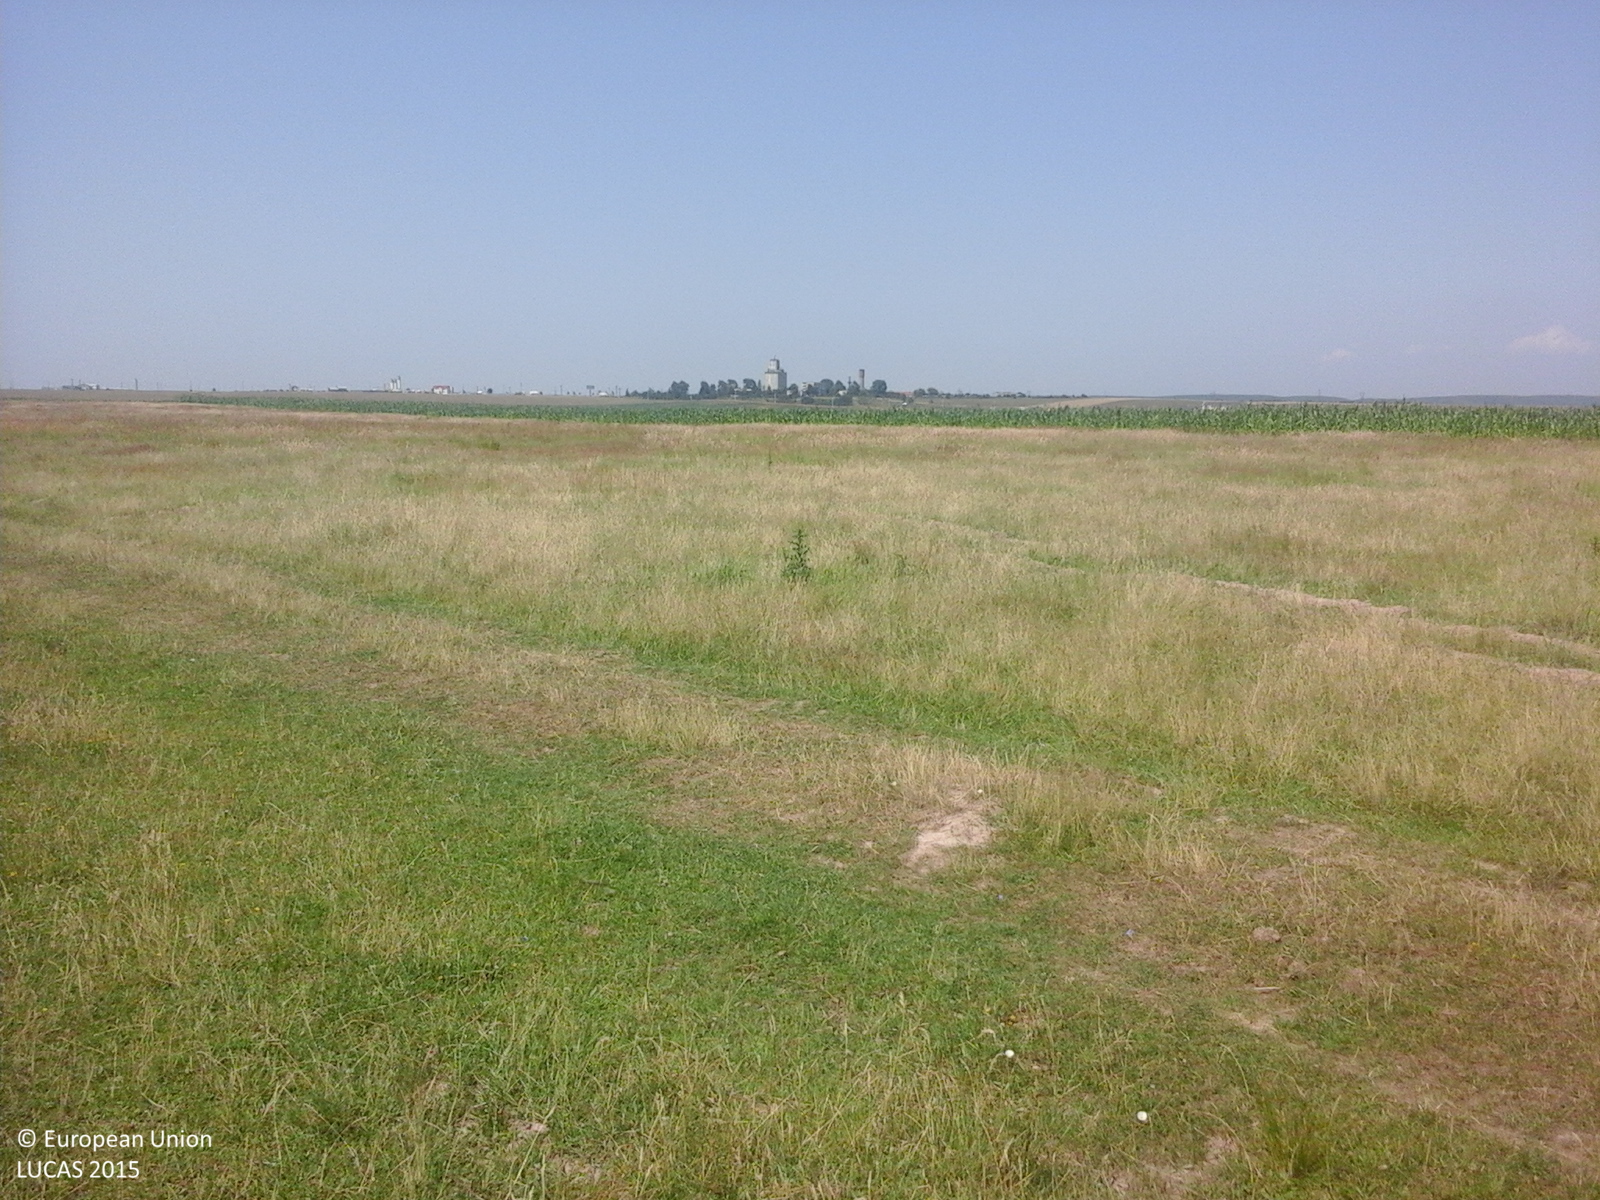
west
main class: Grassland
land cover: Grassland without tree/shrub cover
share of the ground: > 75 %
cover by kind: herbaceous plants 100 %
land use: Agriculture (excluding fallow land and kitchen gardens)
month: July
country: RO
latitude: 44.8079
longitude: 24.8873
